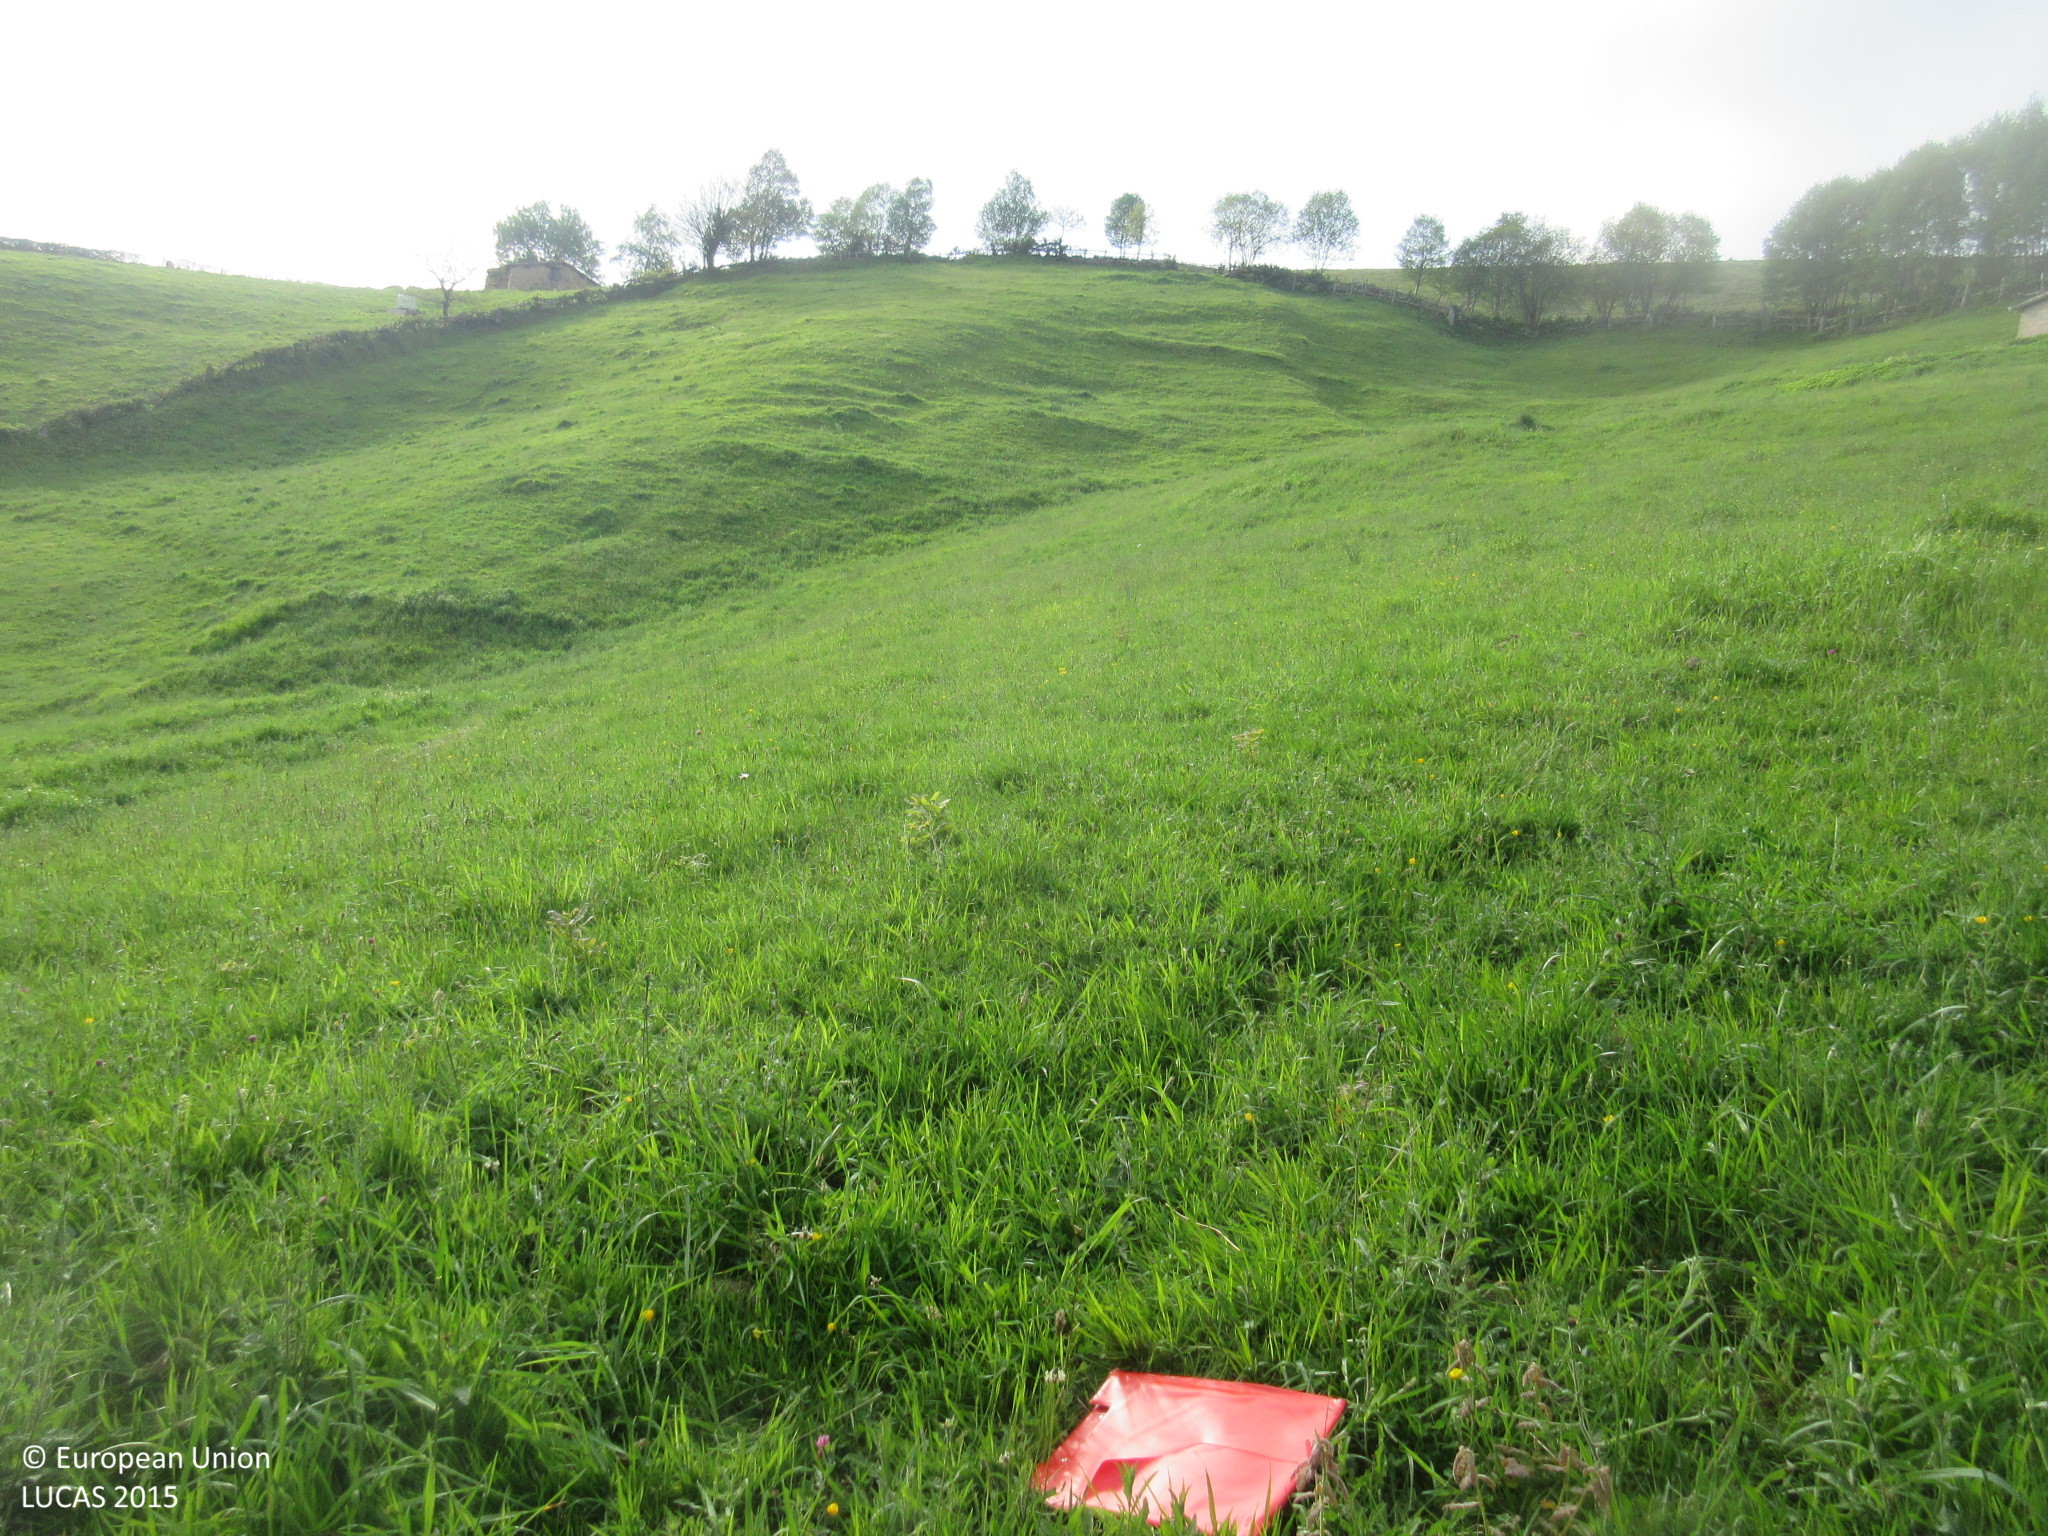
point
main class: Grassland
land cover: Grassland without tree/shrub cover
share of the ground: > 75 %
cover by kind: herbaceous plants 100 %
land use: Agriculture (excluding fallow land and kitchen gardens)
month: May
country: ES
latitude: 43.2455
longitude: -5.8885
